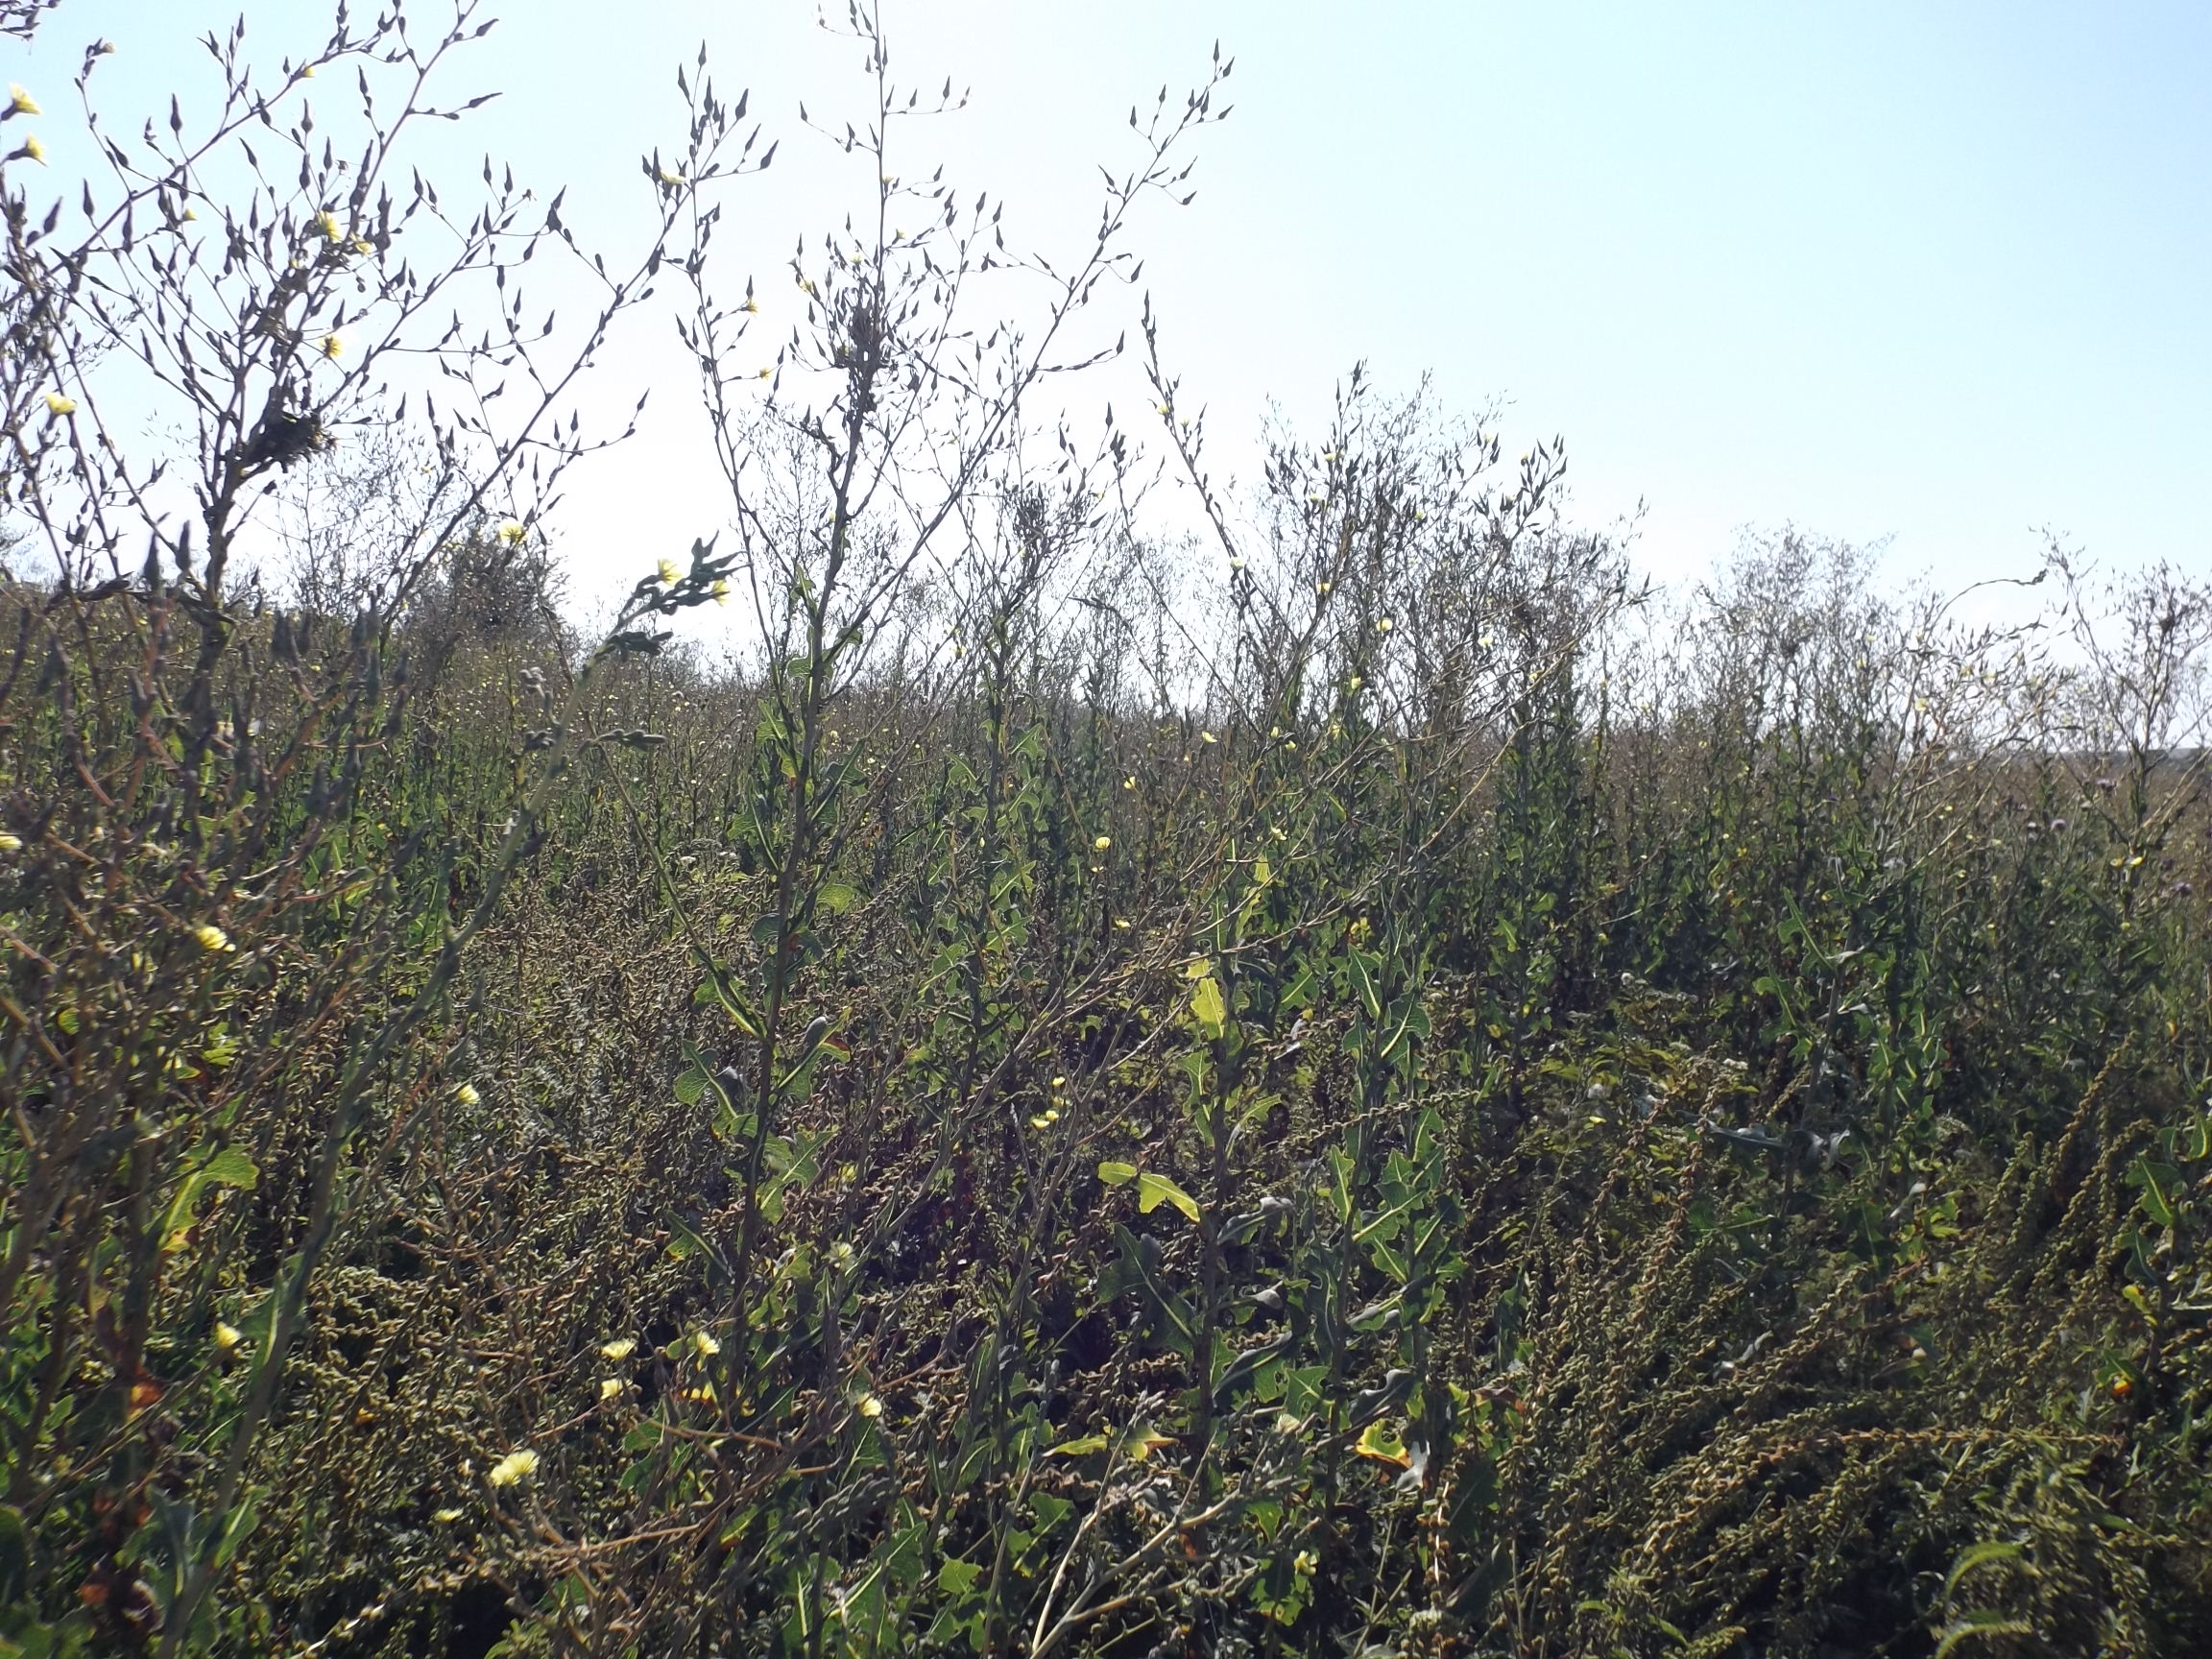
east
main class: Grassland
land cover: Grassland with sparse tree/shrub cover
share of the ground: > 75 %
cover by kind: herbaceous plants 90 %, broadleaved forest trees 5 %, shrubs 5 %
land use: Semi-natural and natural areas not in use
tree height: > 5 m
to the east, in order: Grassland with sparse tree/shrub cover; Tracks; Grassland with sparse tree/shrub cover; Artificial constructions in urban areas
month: August
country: BG
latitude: 43.3427
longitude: 27.9419
